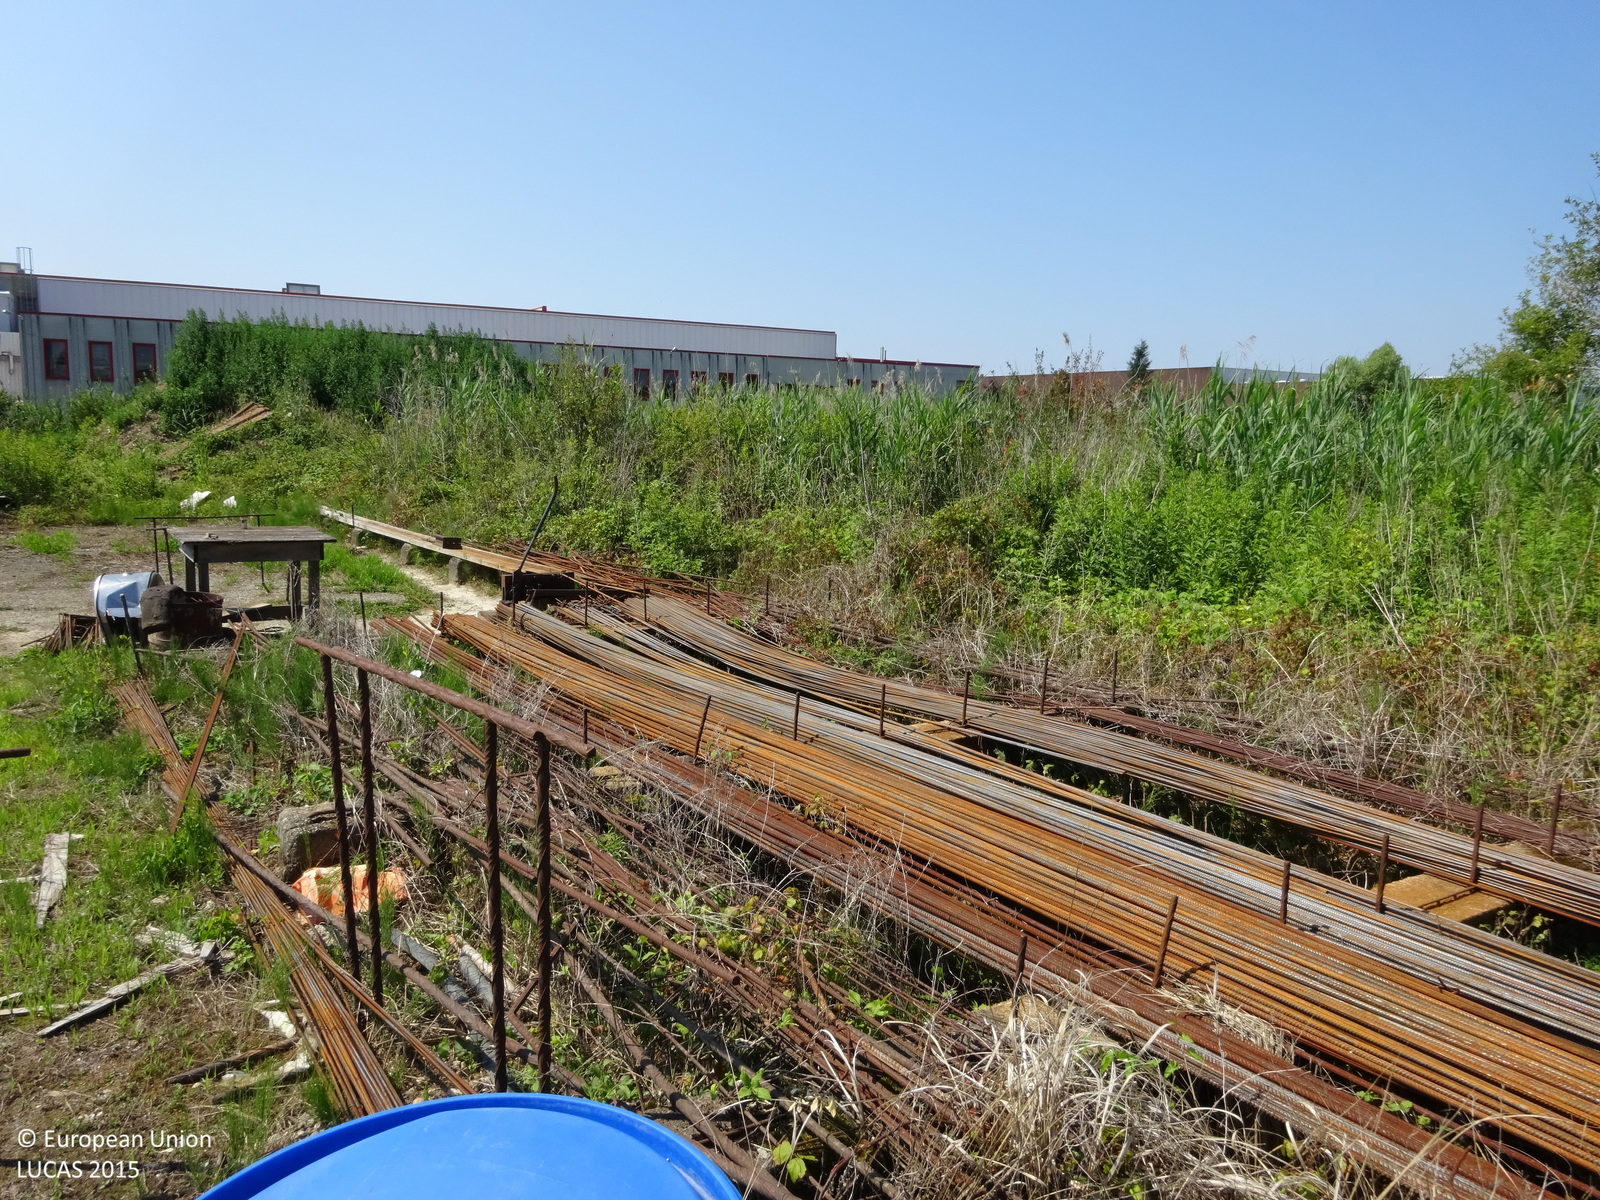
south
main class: Grassland
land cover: Spontaneously vegetated surfaces
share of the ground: 25 - 50 %
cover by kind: herbaceous plants 60 %, consolidated bare surface 20 %, unconsolidated bare surface 20 %
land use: Construction
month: July
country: AT
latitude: 46.9335
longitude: 16.1352
